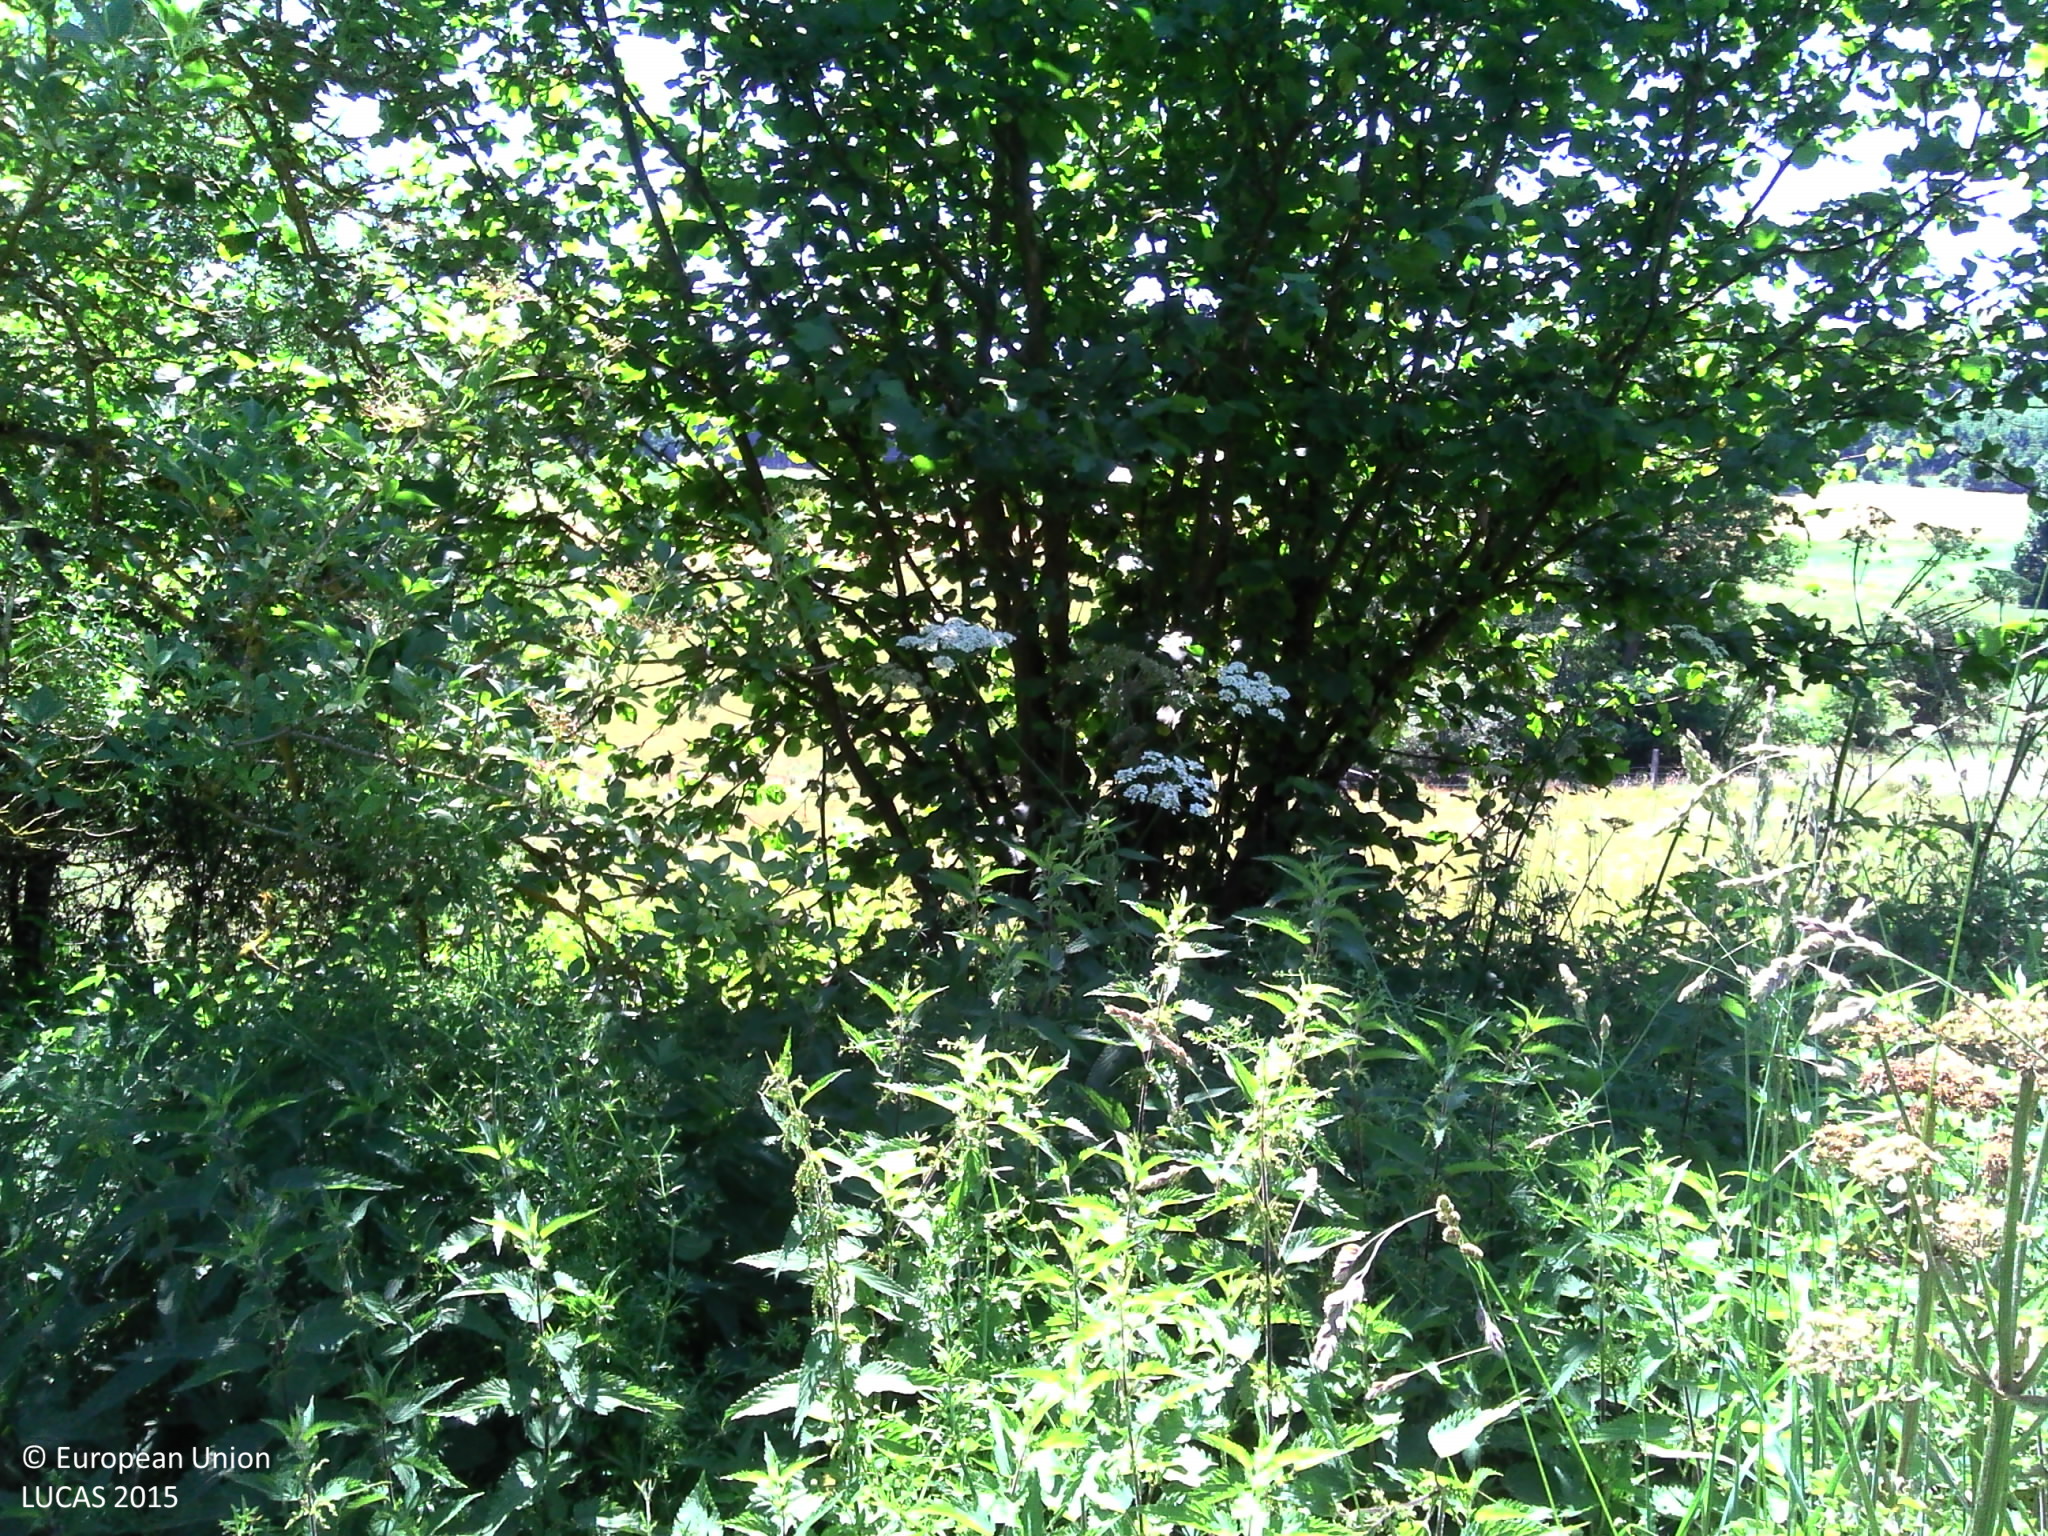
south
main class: Grassland
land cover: Grassland without tree/shrub cover
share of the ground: > 75 %
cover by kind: herbaceous plants 100 %
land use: Agriculture (excluding fallow land and kitchen gardens)
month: July
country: BE
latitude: 50.0823
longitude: 5.6243
